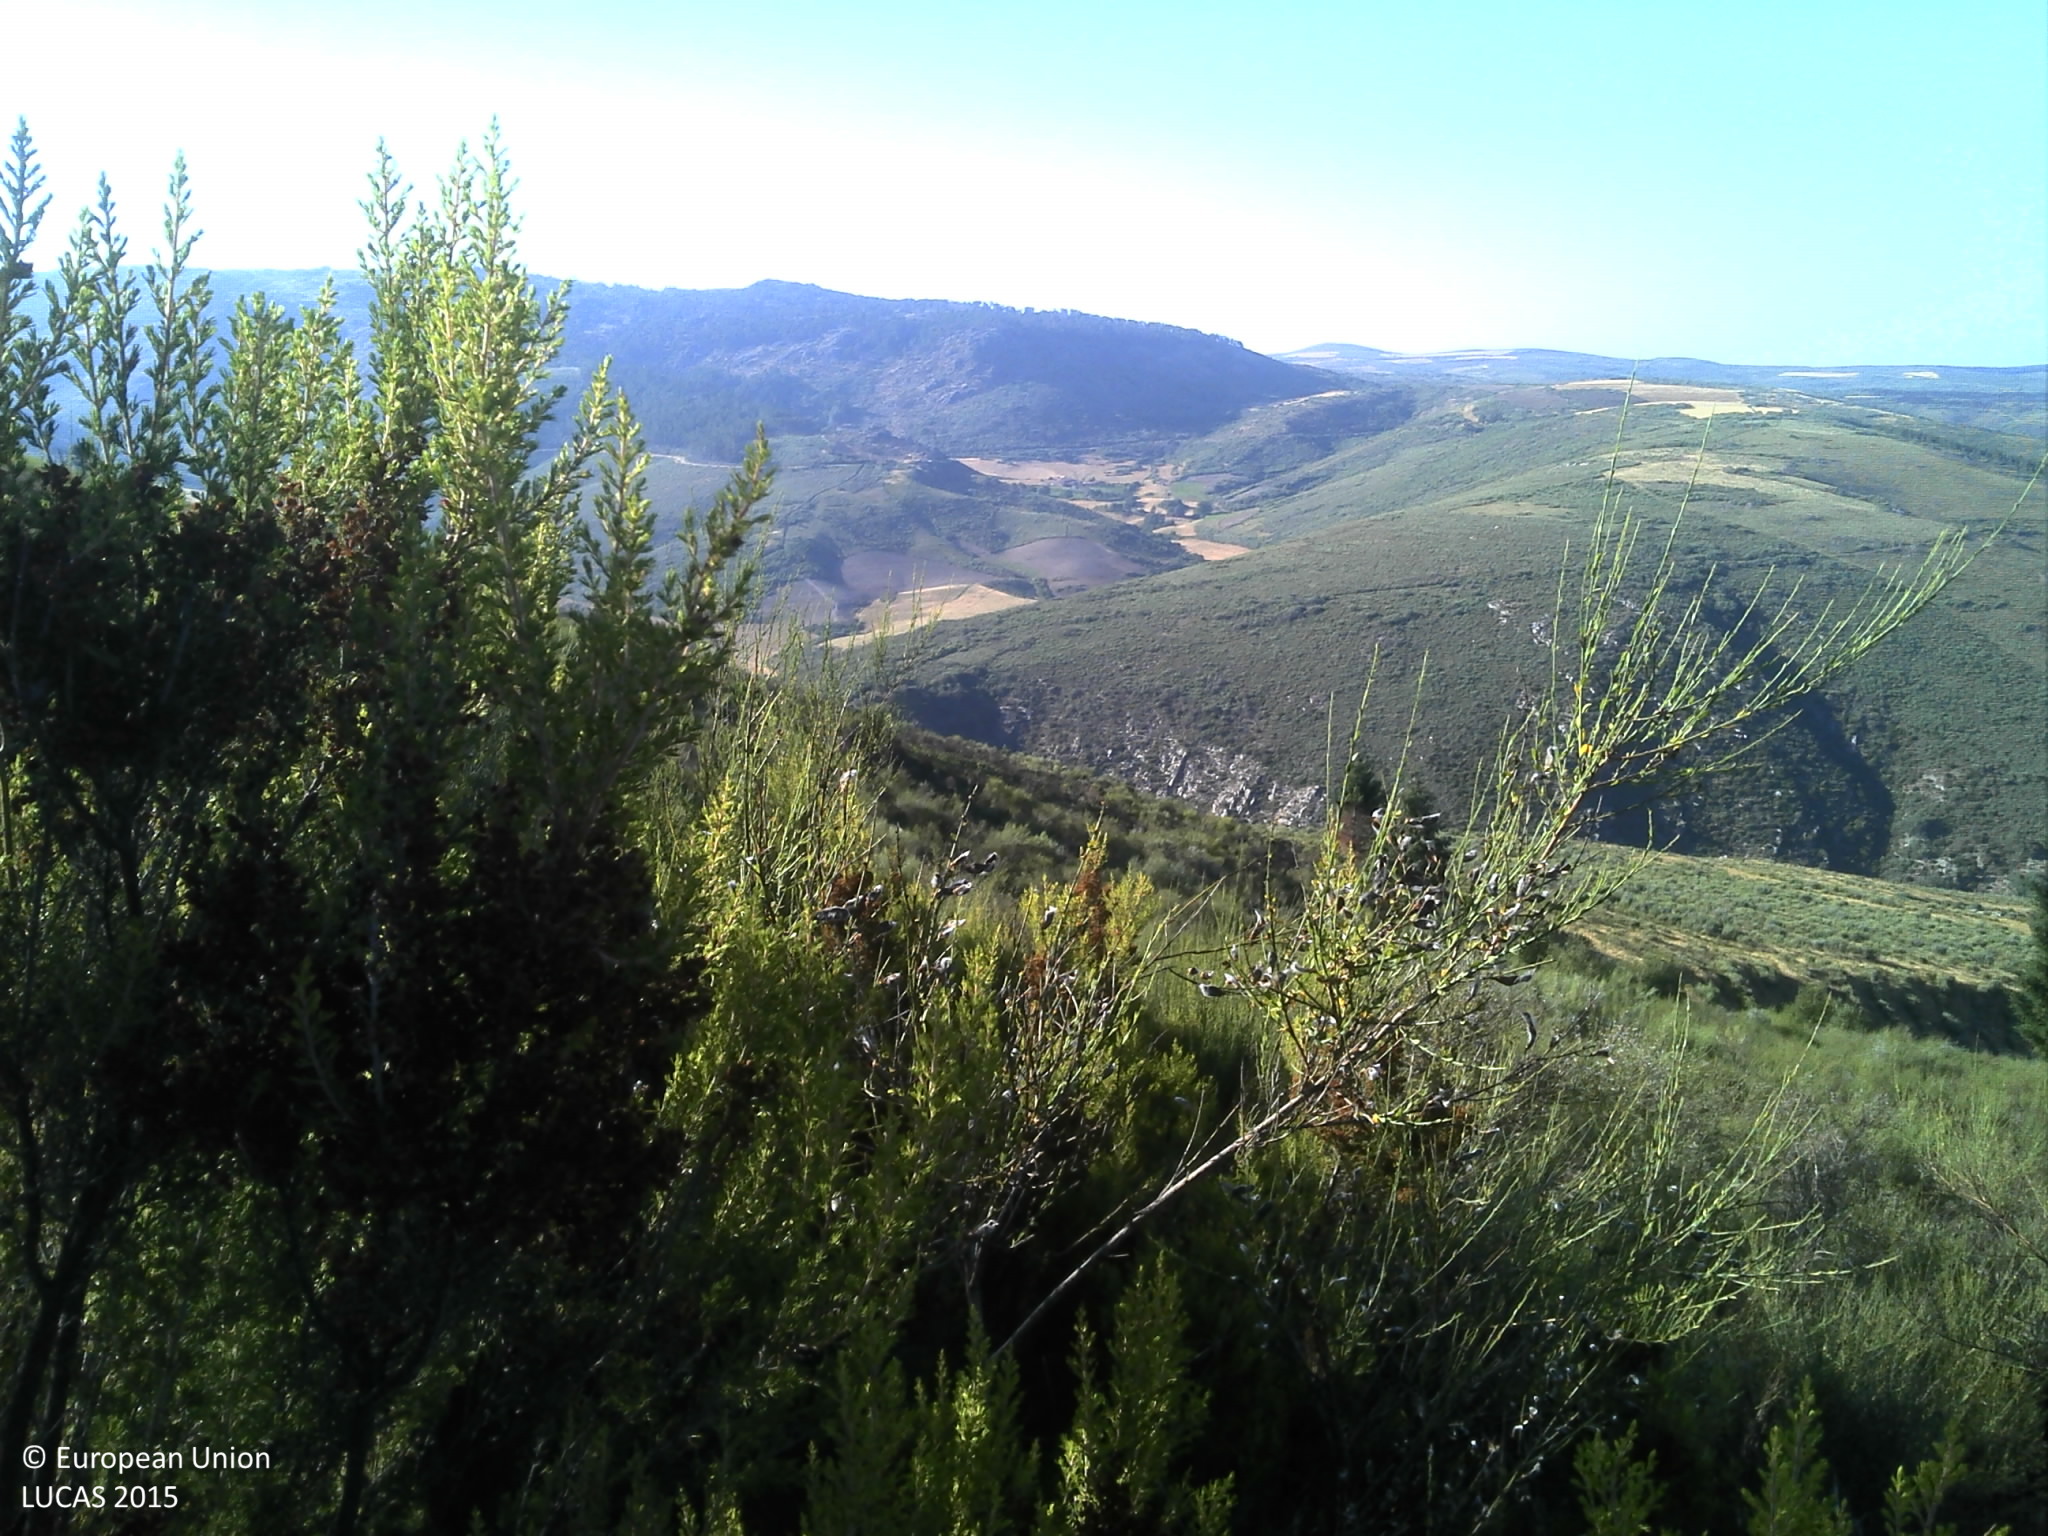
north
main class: Shrubland
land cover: Shrubland without tree cover
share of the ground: > 75 %
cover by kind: shrubs 90 %, unconsolidated bare surface 10 %
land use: Abandoned areas
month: July
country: PT
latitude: 40.4561
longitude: -7.4795
